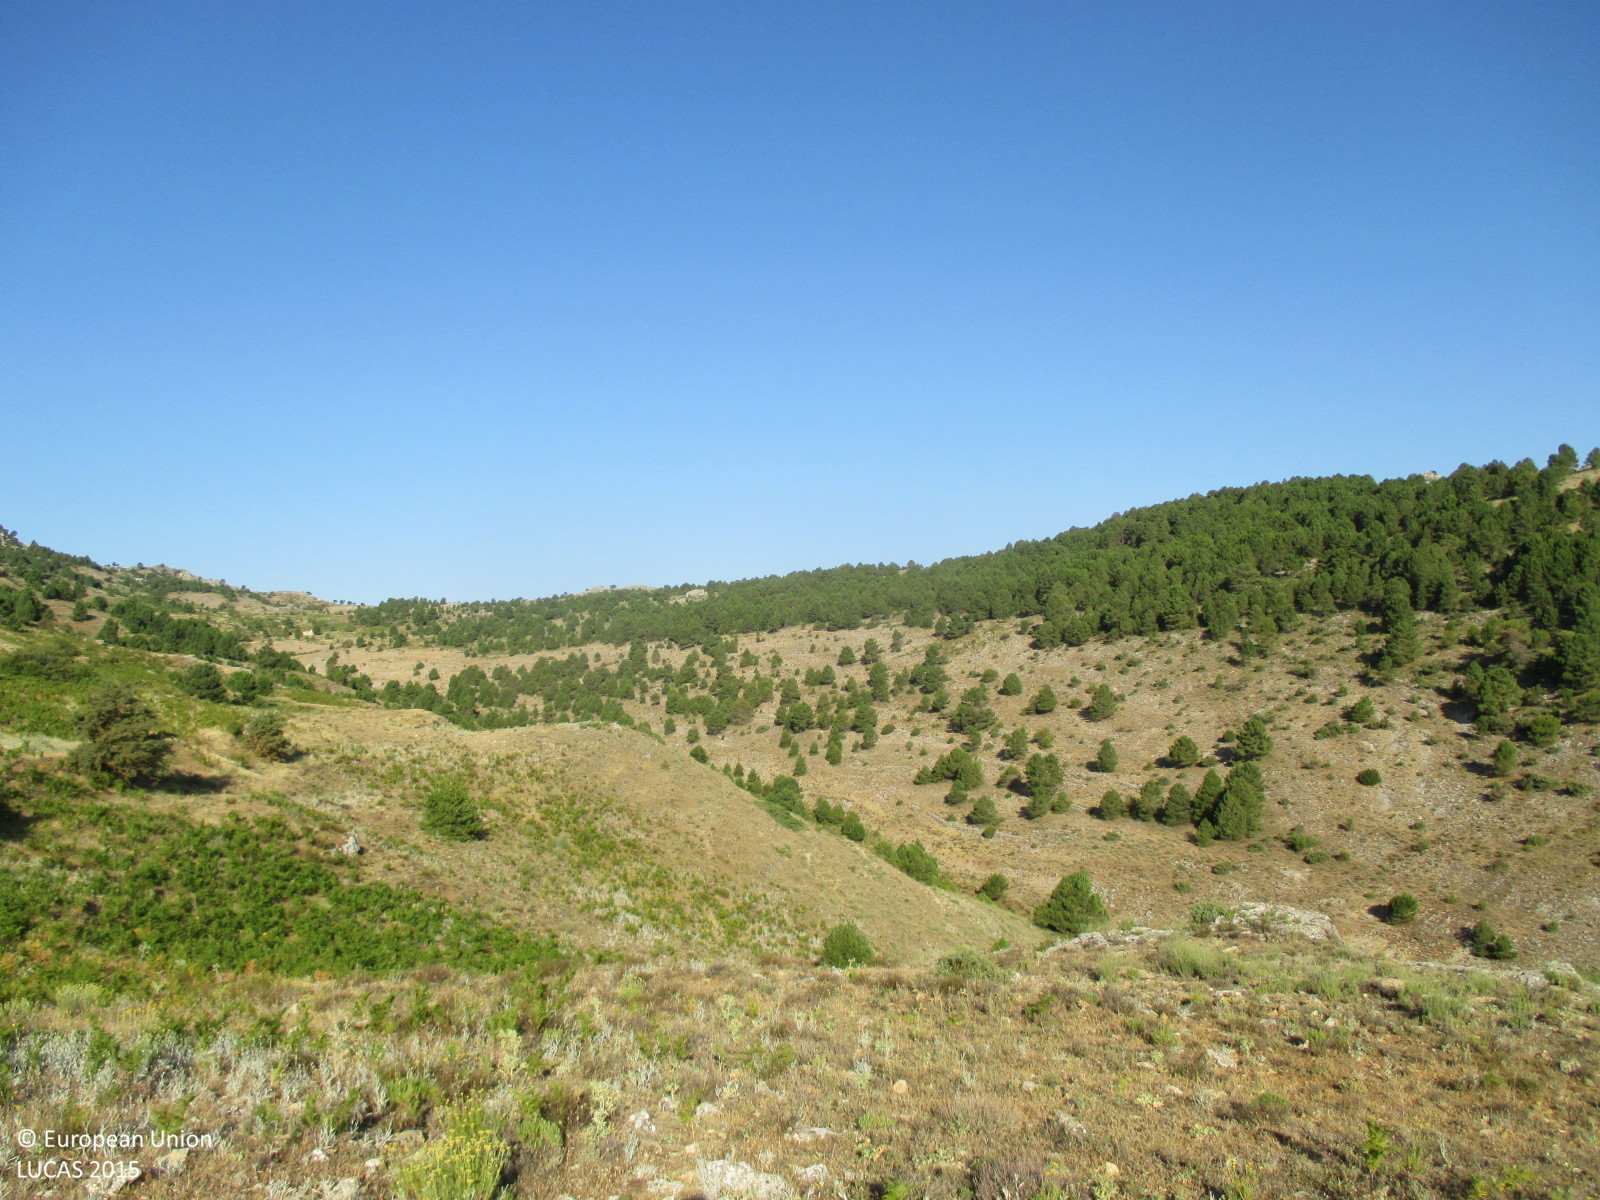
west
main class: Grassland
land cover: Grassland without tree/shrub cover
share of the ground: > 75 %
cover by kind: herbaceous plants 90 %, consolidated bare surface 10 %
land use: Semi-natural and natural areas not in use
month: July
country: ES
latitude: 38.3537
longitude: -2.4584
